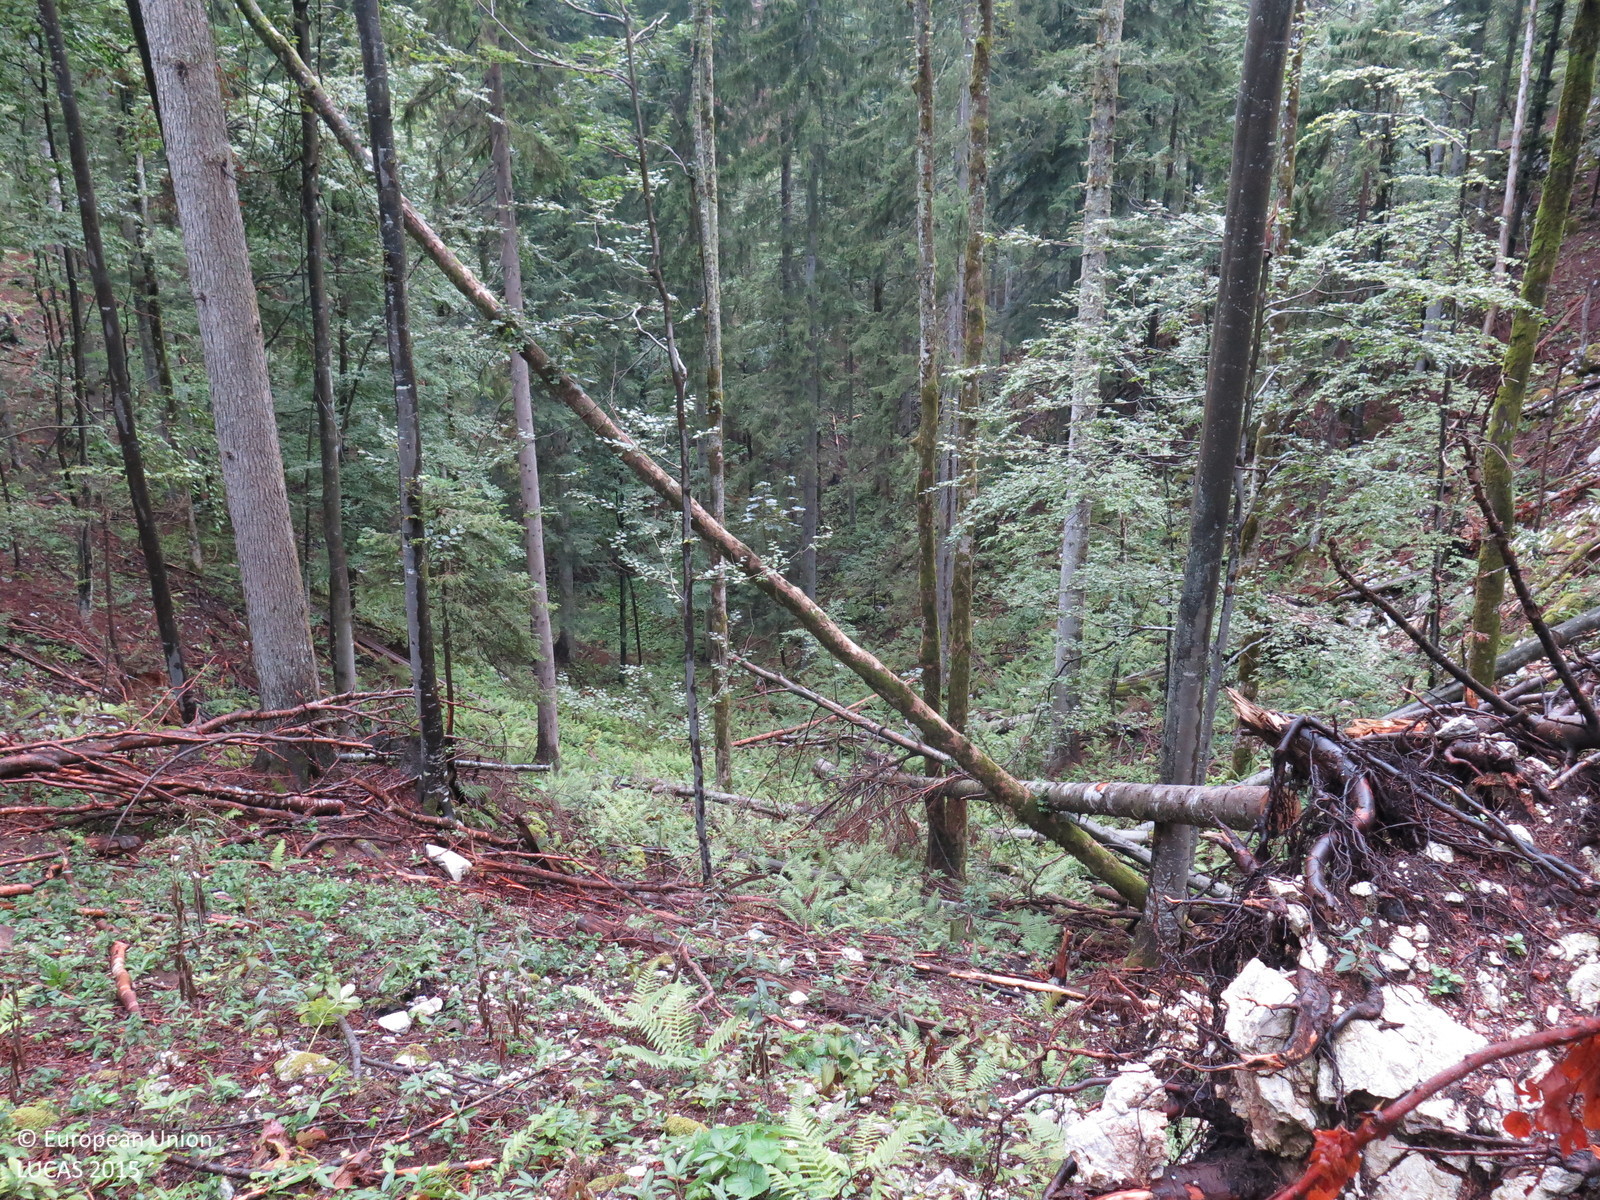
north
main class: Woodland
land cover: Other coniferous woodland
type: alpine coniferous forest
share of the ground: > 75 %
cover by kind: coniferous forest trees 90 %, broadleaved forest trees 5 %, unconsolidated bare surface 5 %
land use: Forestry
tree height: > 5 m
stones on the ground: 25 - 50 %
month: September
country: HR
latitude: 45.4545
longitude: 14.6883
